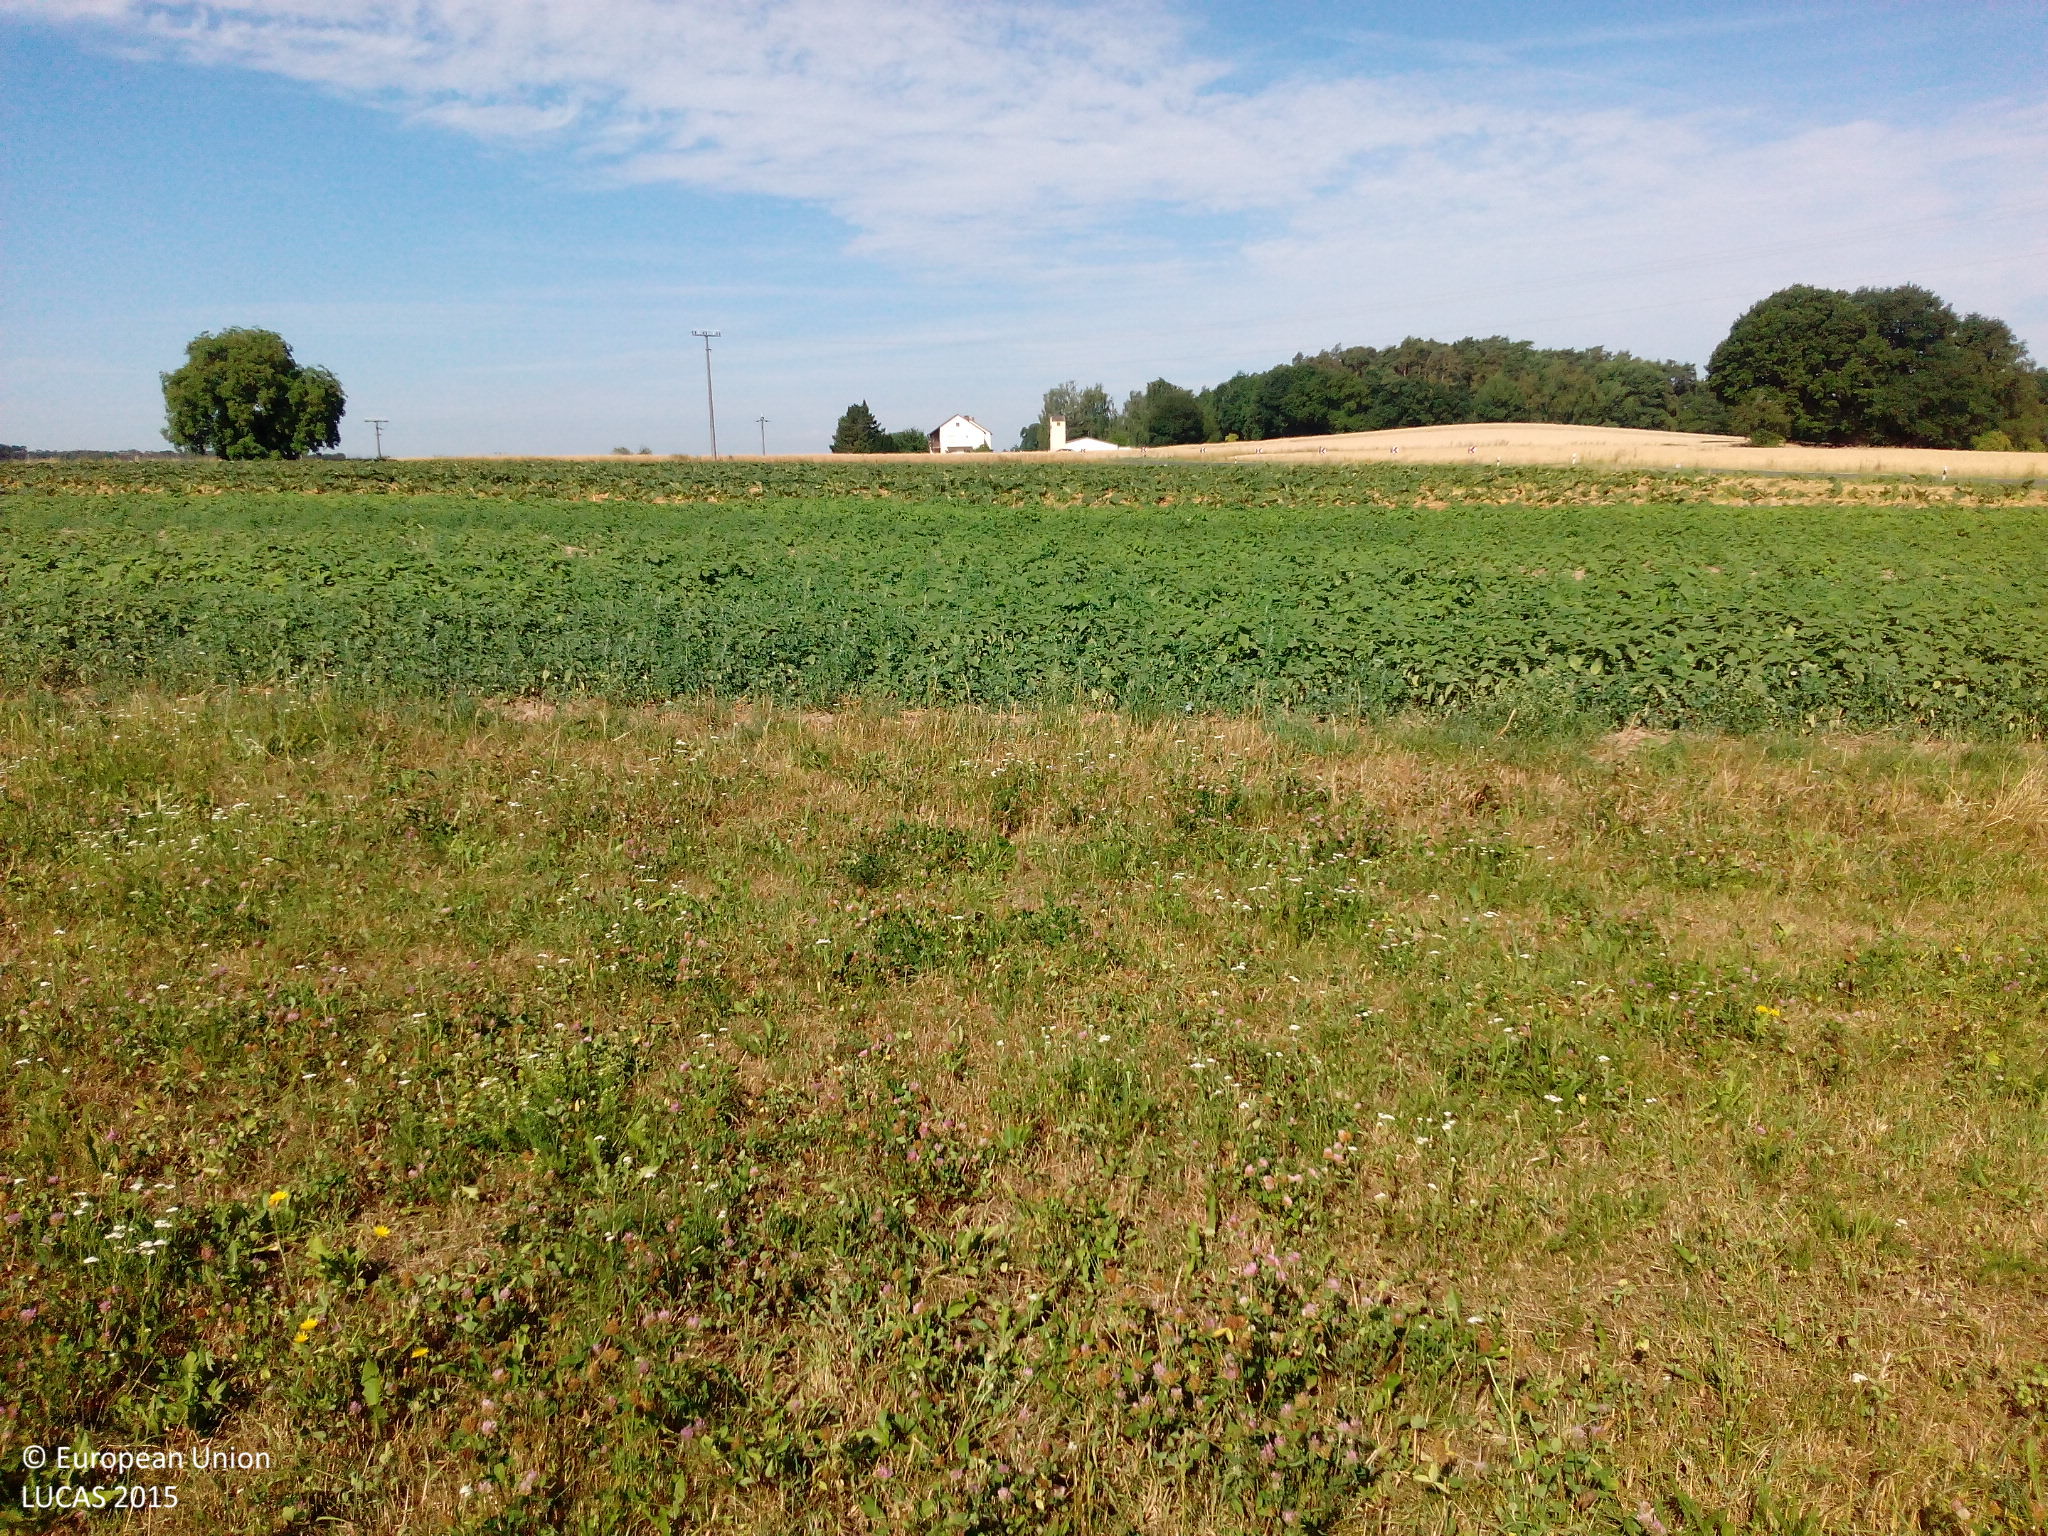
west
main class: Cropland
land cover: Apple fruit
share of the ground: < 10 %
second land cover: Grassland without tree/shrub cover
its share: > 75 %
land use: Agriculture (excluding fallow land and kitchen gardens)
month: July
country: DE
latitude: 49.4071
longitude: 10.9230
